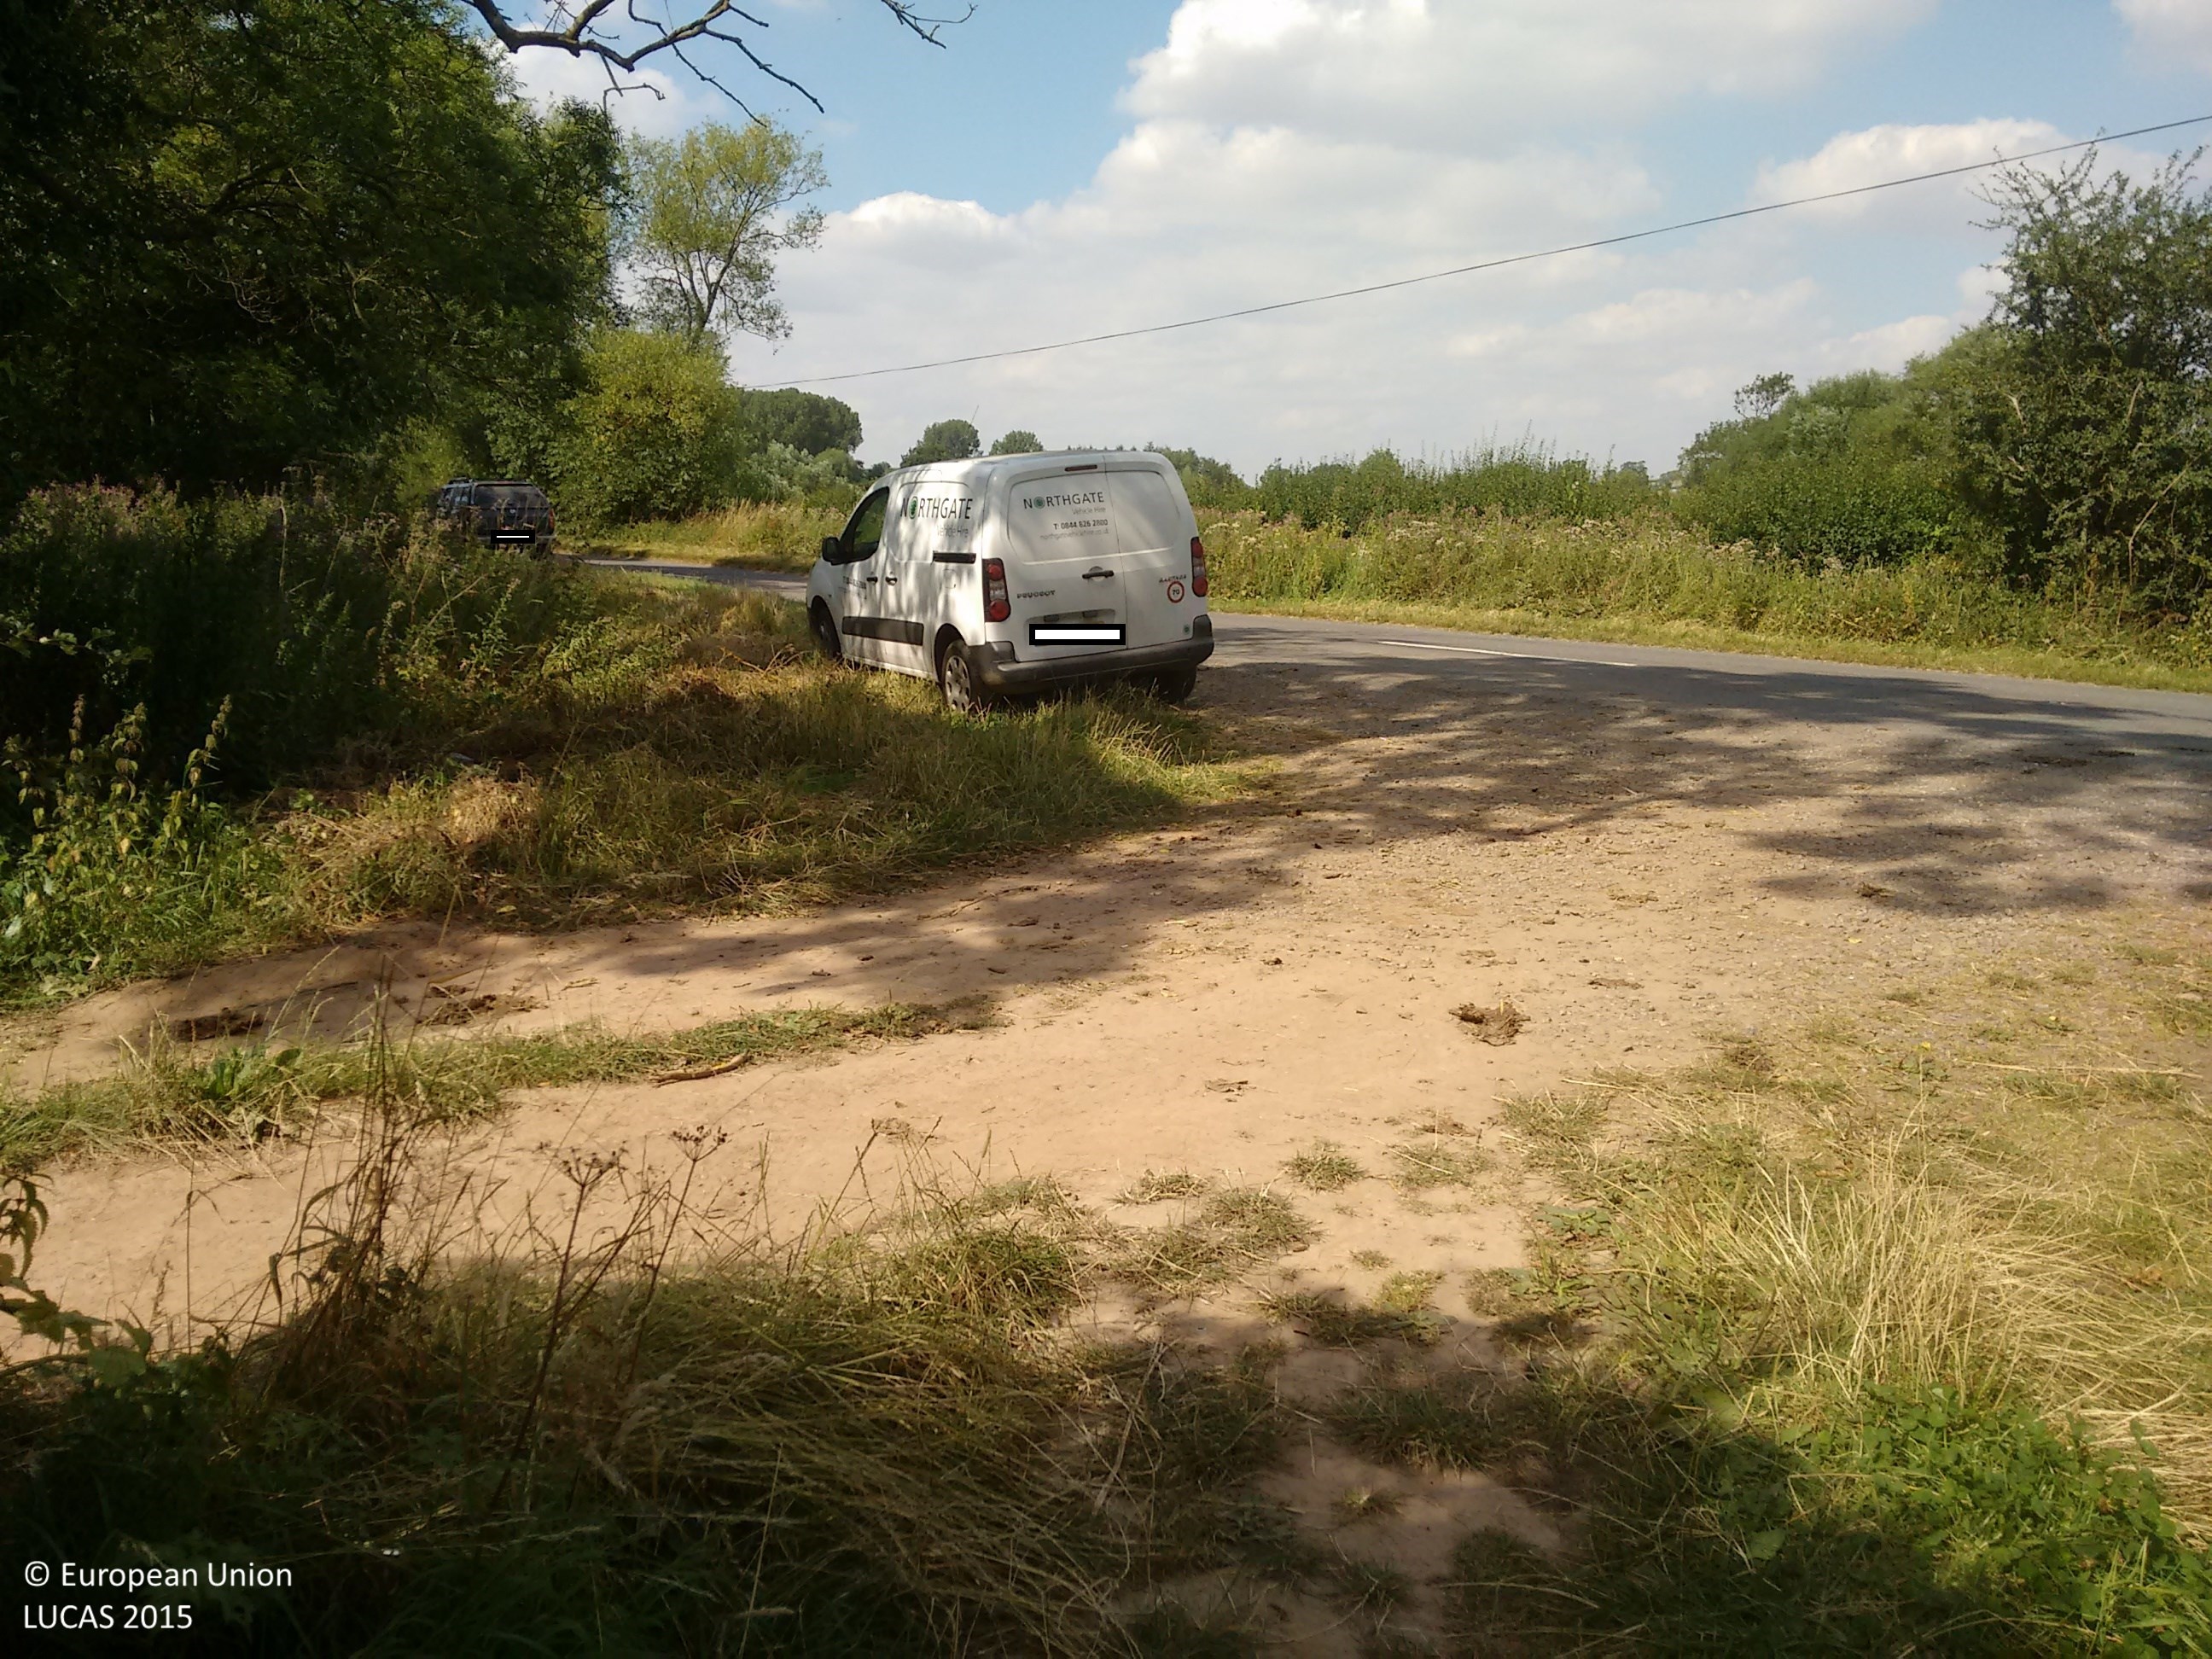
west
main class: Grassland
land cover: Grassland without tree/shrub cover
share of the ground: > 75 %
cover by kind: herbaceous plants 100 %
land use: Agriculture (excluding fallow land and kitchen gardens)
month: August
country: GB
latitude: 52.6160
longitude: -1.4974
